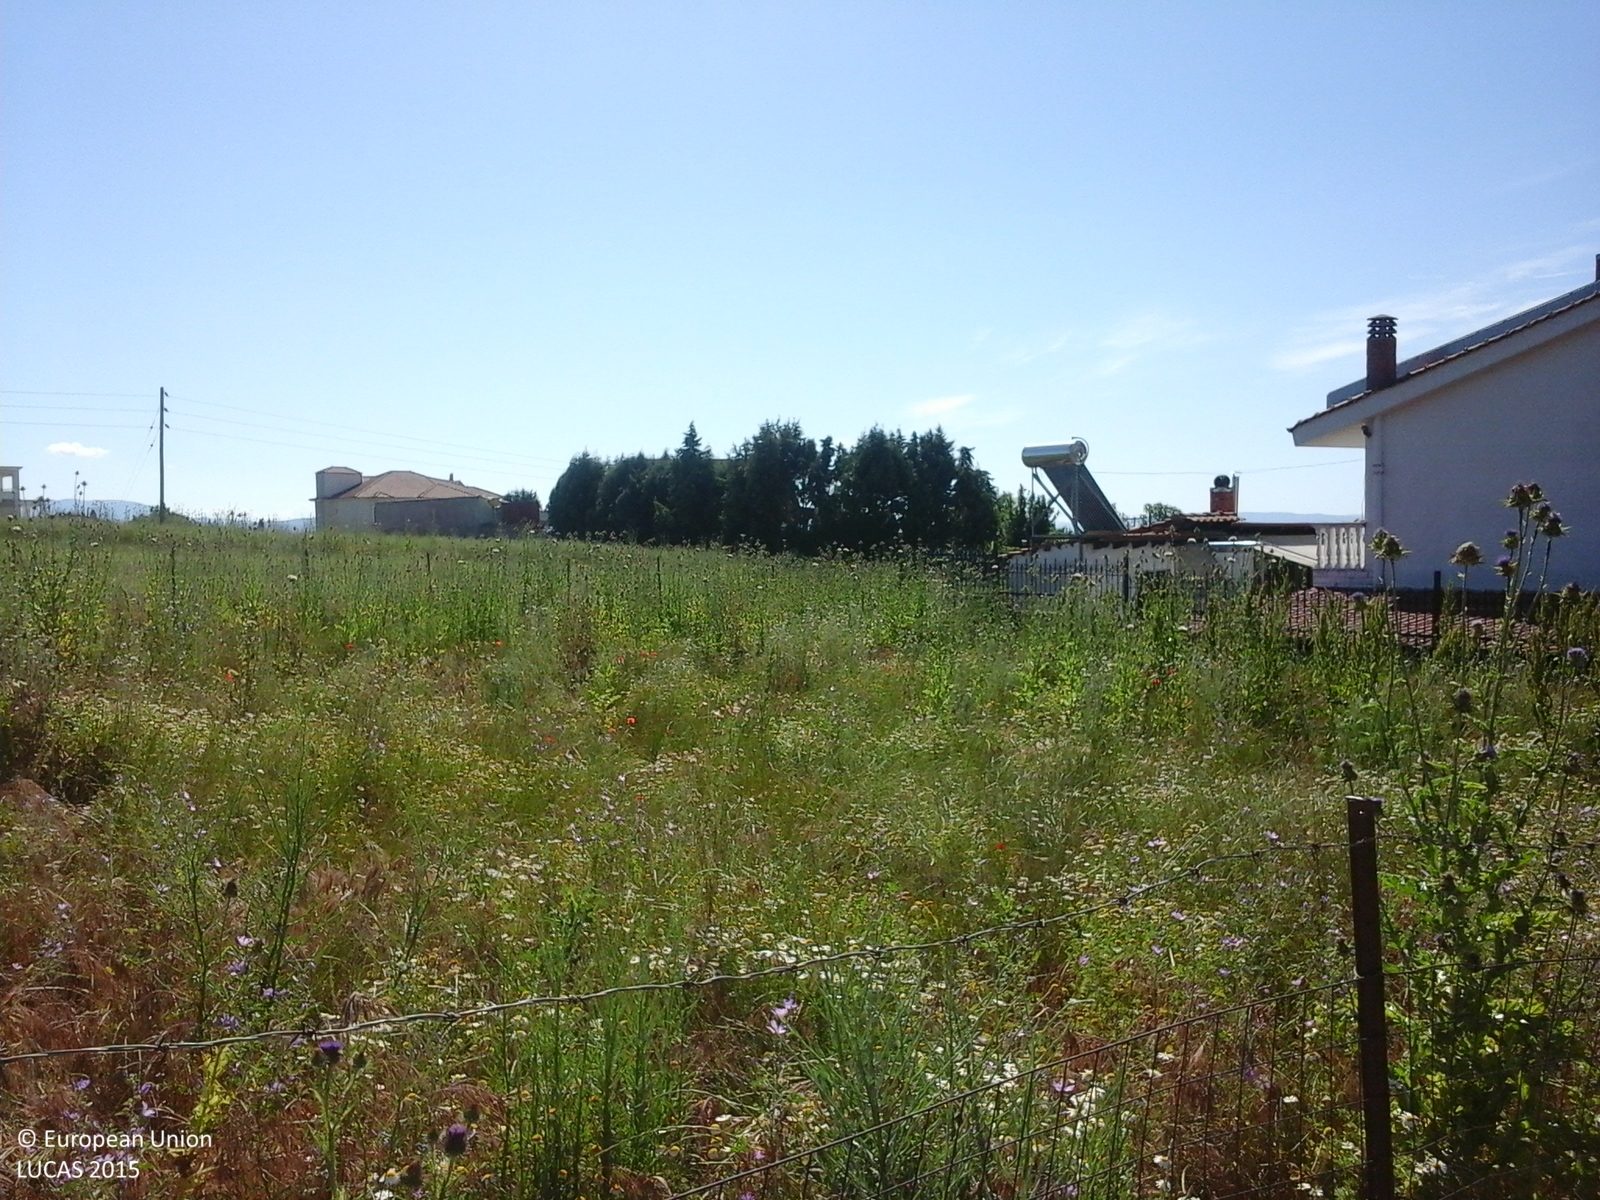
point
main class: Grassland
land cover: Spontaneously vegetated surfaces
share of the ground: > 75 %
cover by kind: herbaceous plants 10 %
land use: Fallow land
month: May
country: GR
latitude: 40.7758
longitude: 22.9593
